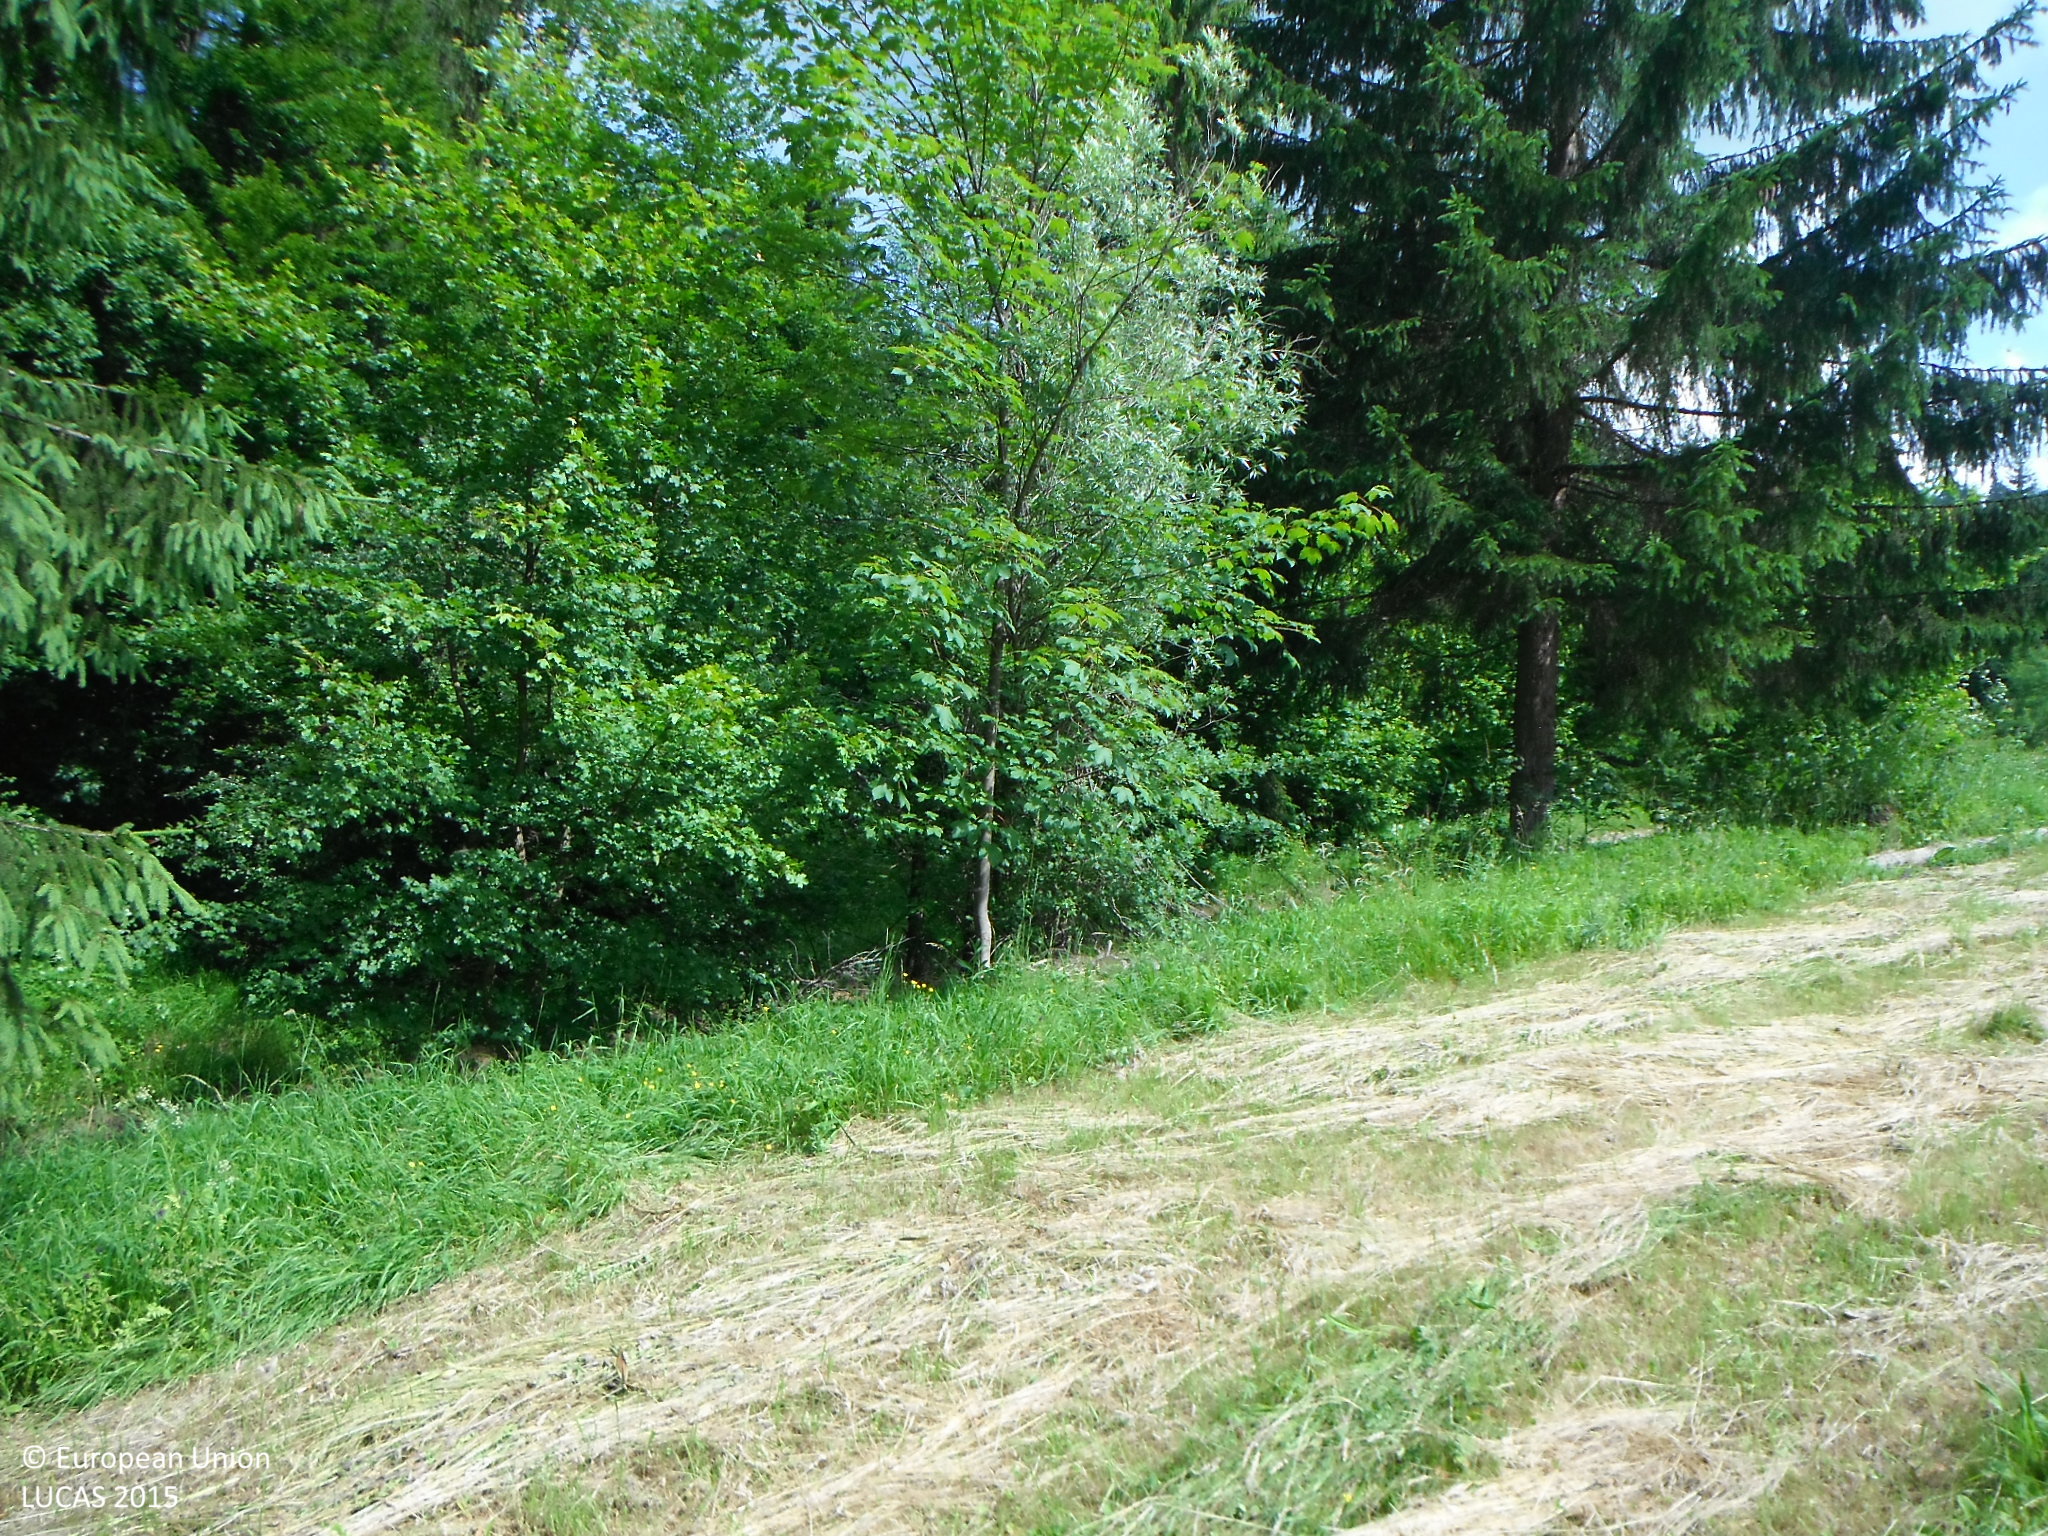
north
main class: Grassland
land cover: Grassland without tree/shrub cover
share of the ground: > 75 %
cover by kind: herbaceous plants 100 %
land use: Agriculture (excluding fallow land and kitchen gardens)
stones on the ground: < 10 %
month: June
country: SK
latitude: 49.2356
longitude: 19.3780
